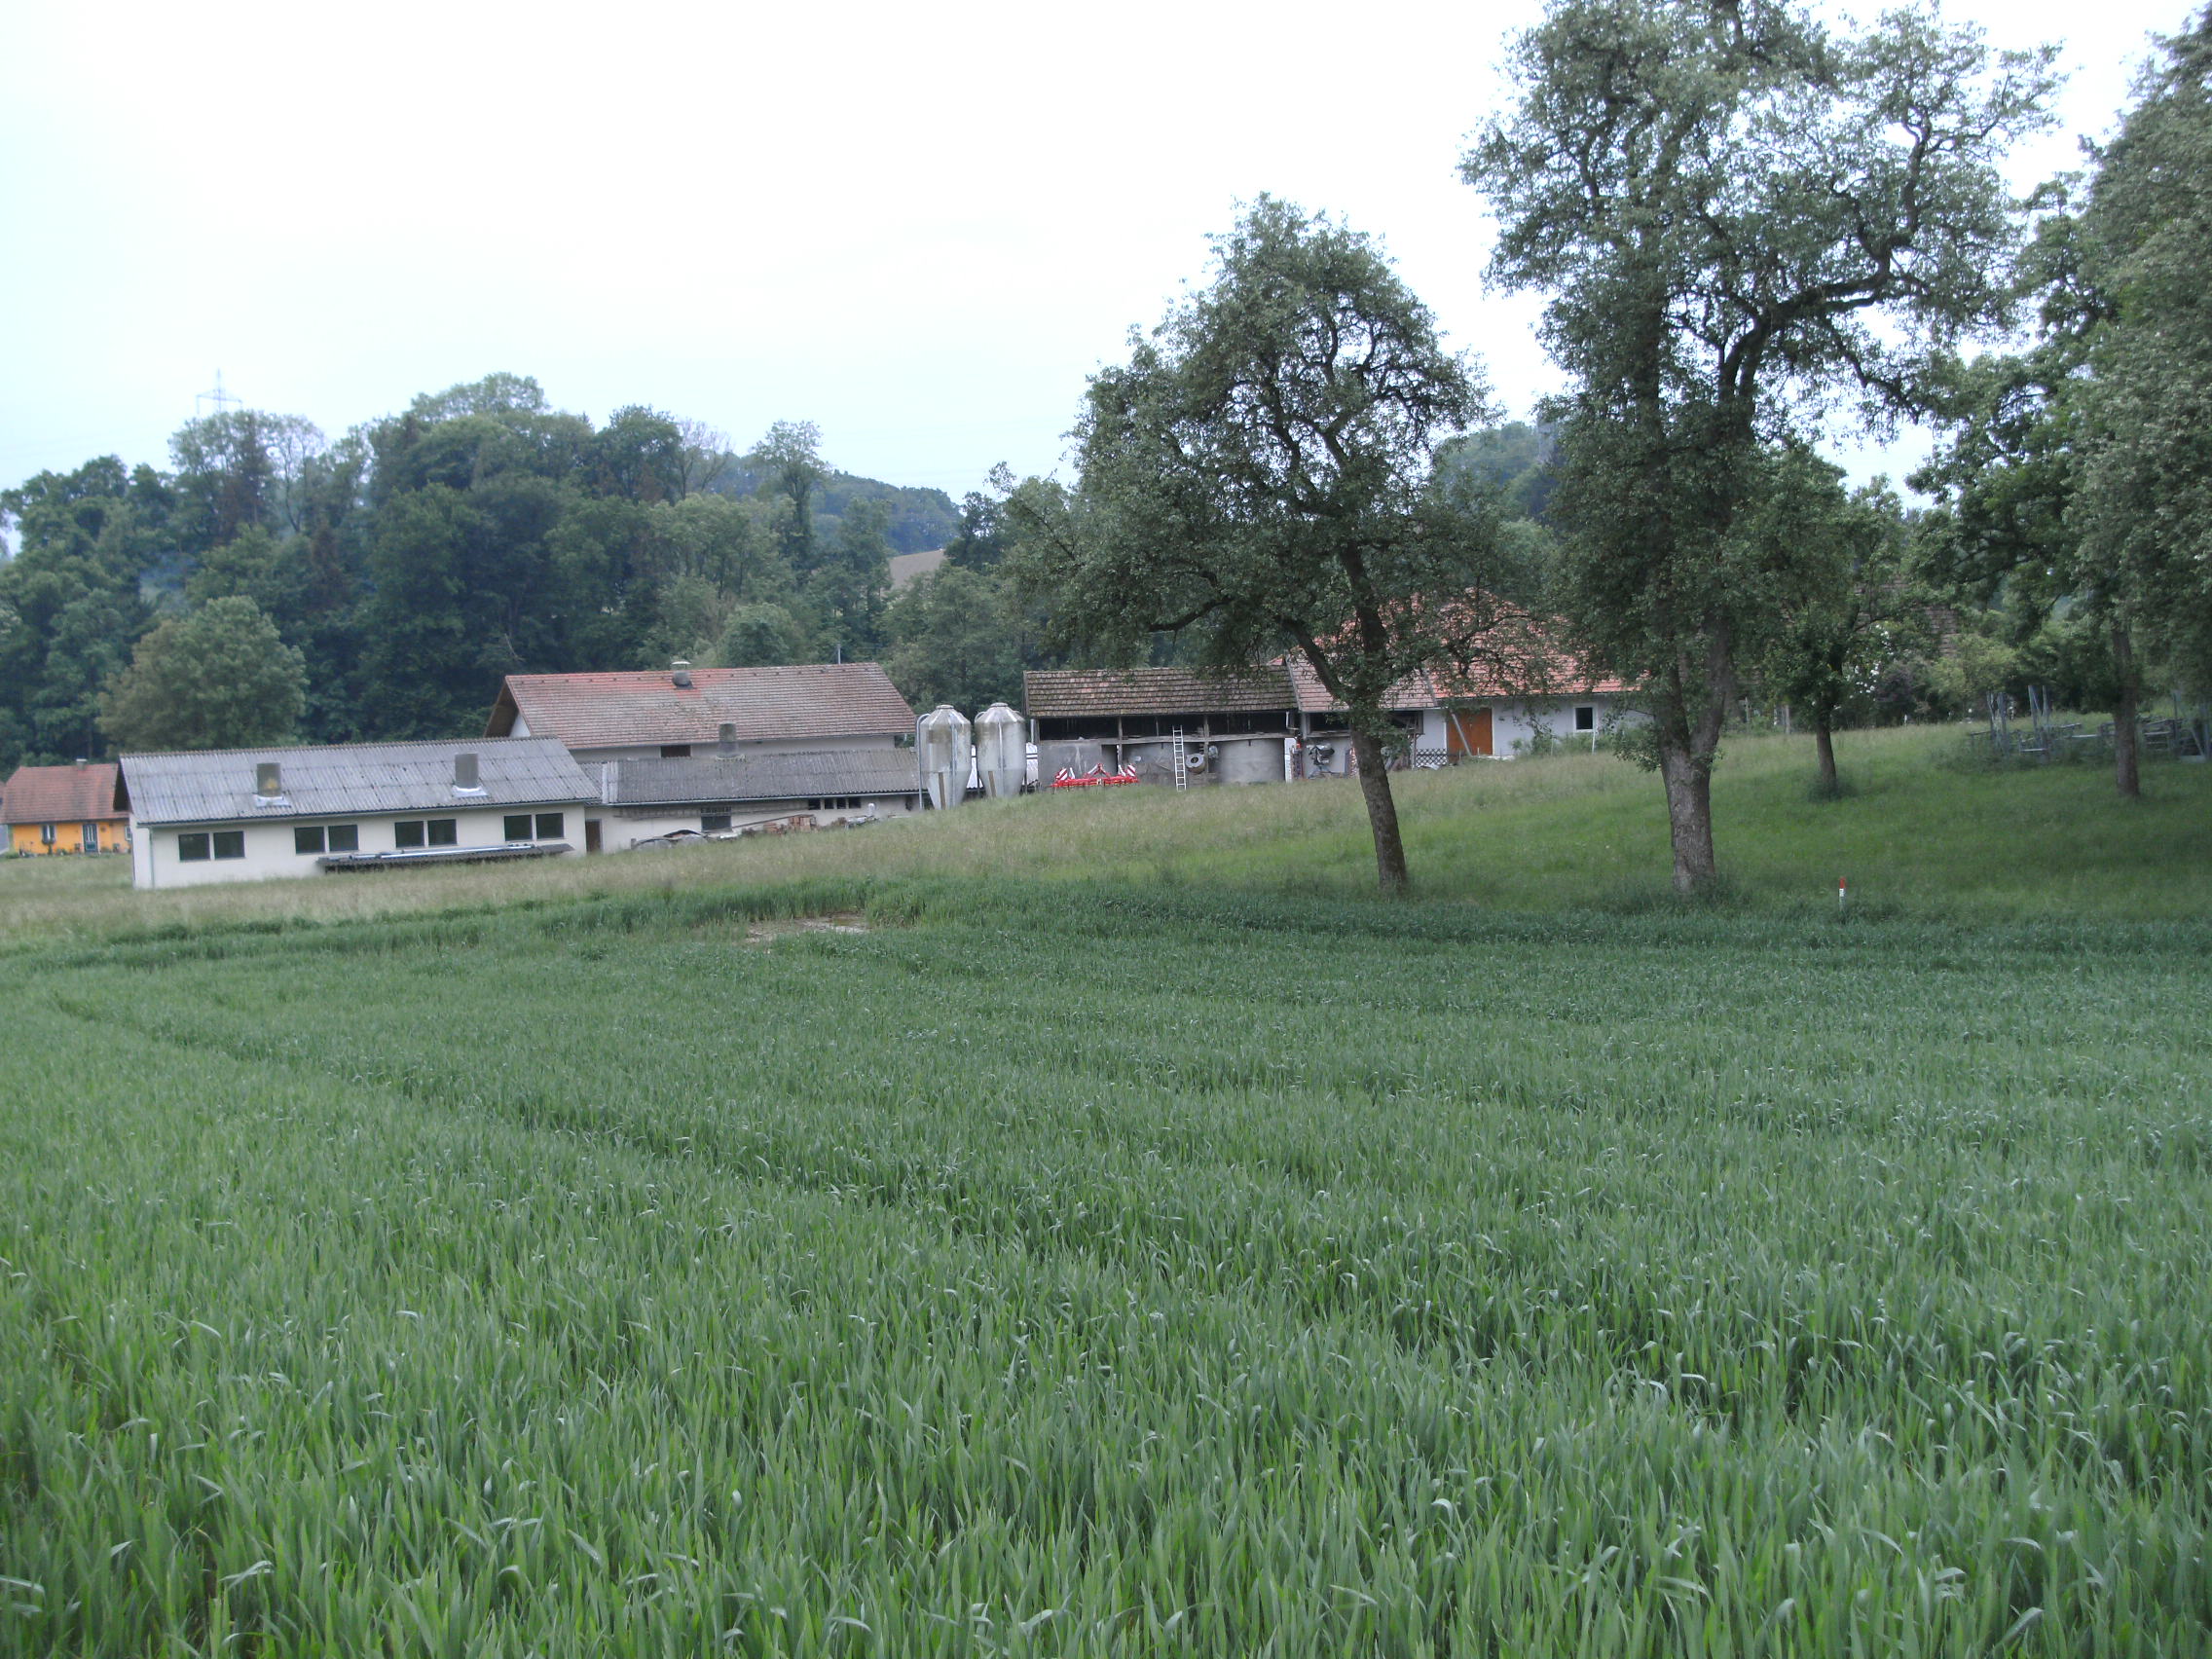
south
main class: Cropland
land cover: Common wheat
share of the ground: > 75 %
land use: Agriculture (excluding fallow land and kitchen gardens)
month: May
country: AT
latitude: 48.1400
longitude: 13.8026
